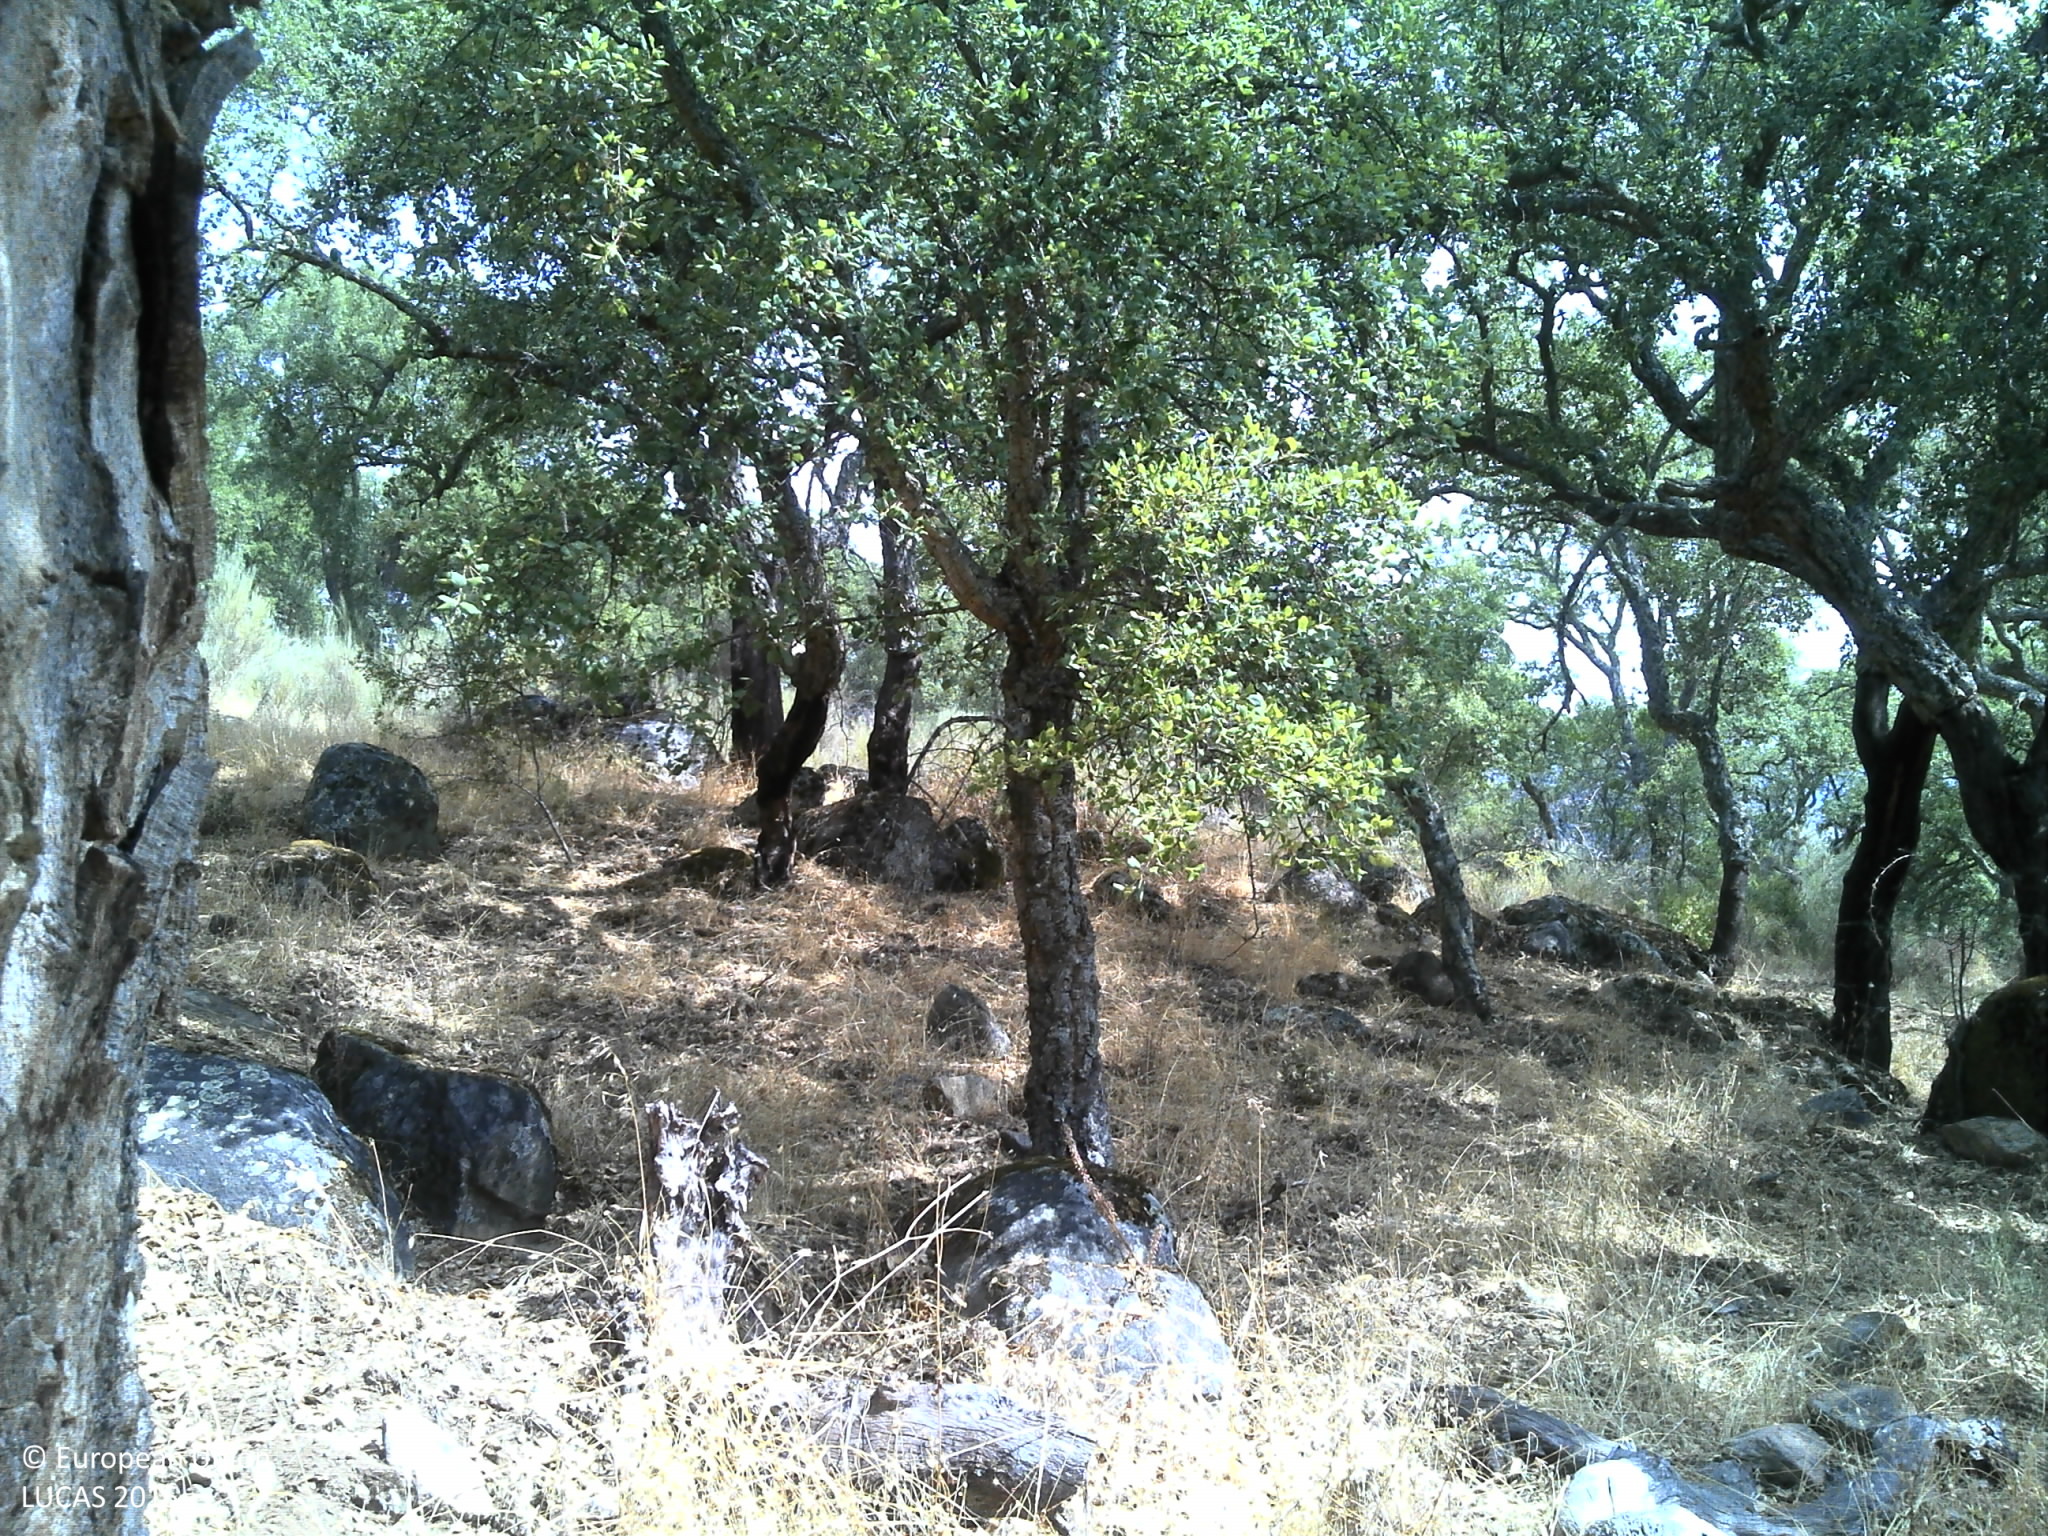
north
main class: Woodland
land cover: Broadleaved woodland
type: broadleaved evergreen forest
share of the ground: 25 - 50 %
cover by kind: broadleaved forest trees 50 %, consolidated bare surface 50 %
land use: Forestry
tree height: > 5 m
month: August
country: PT
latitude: 39.2778
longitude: -7.4650
